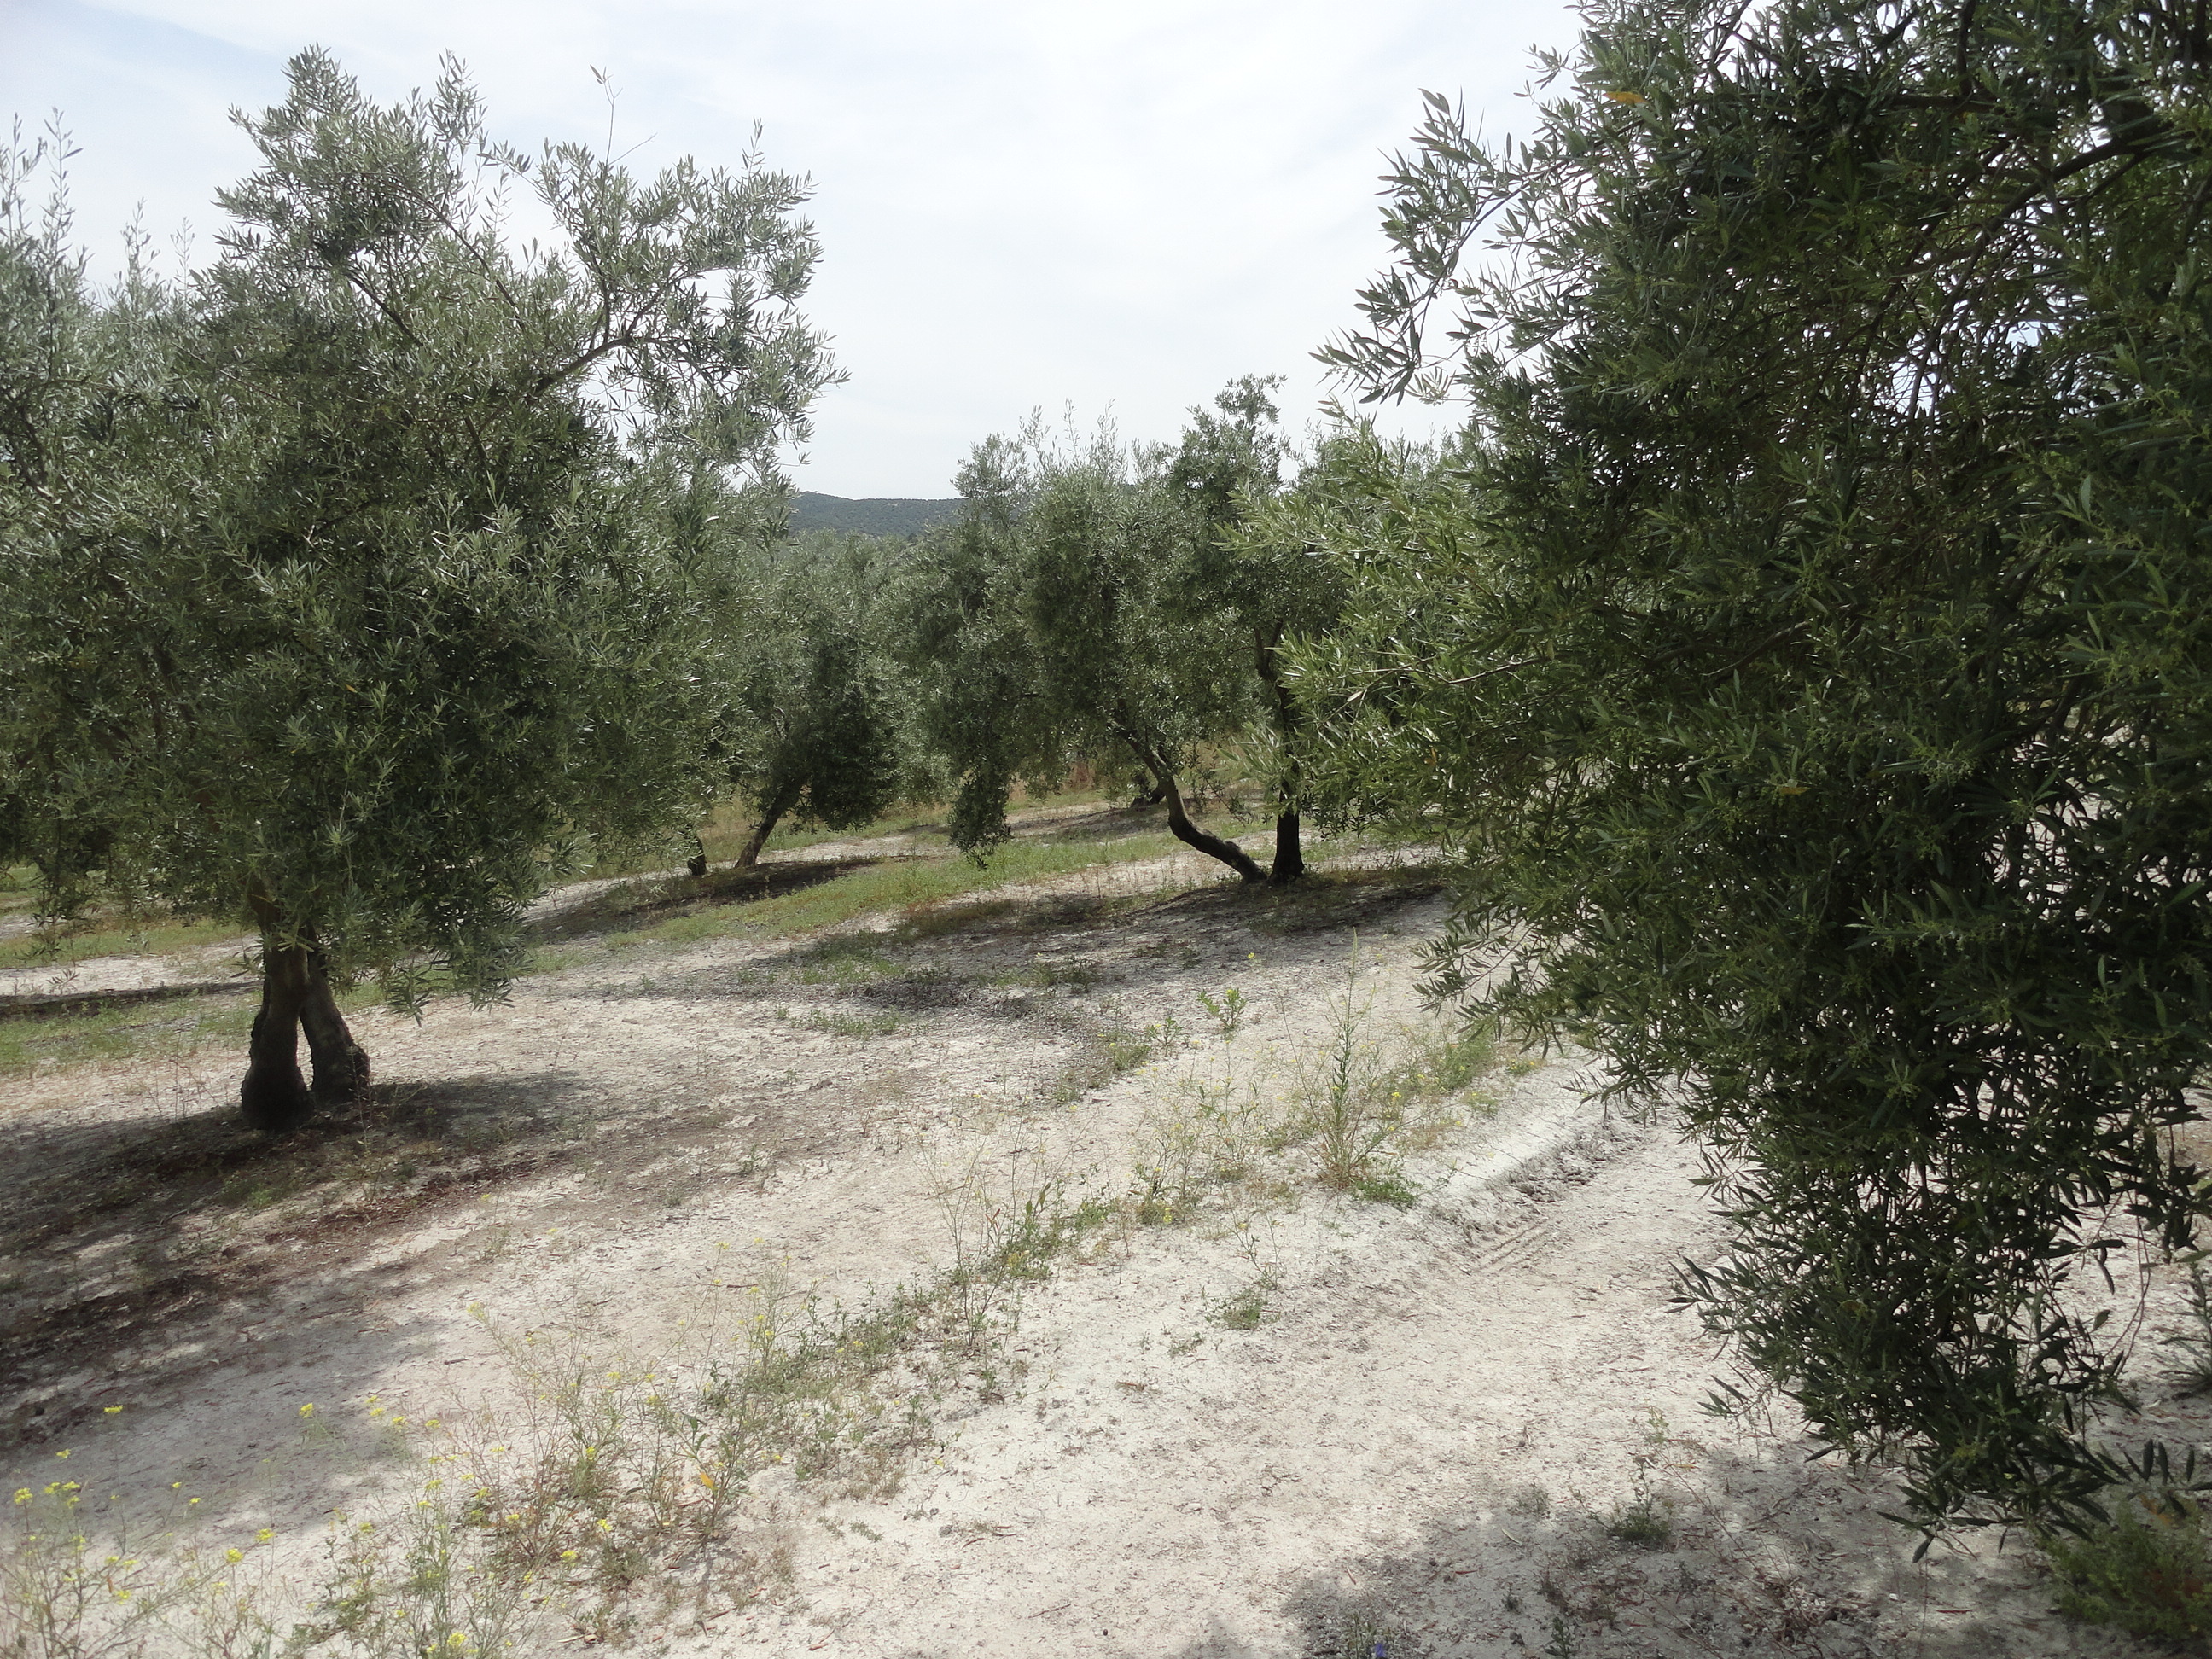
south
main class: Cropland
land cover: Olive groves
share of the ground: 50 - 75 %
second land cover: Spontaneously vegetated surfaces
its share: 10 - 25 %
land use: Agriculture (excluding fallow land and kitchen gardens)
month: April
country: ES
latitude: 37.6121
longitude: -4.4494
